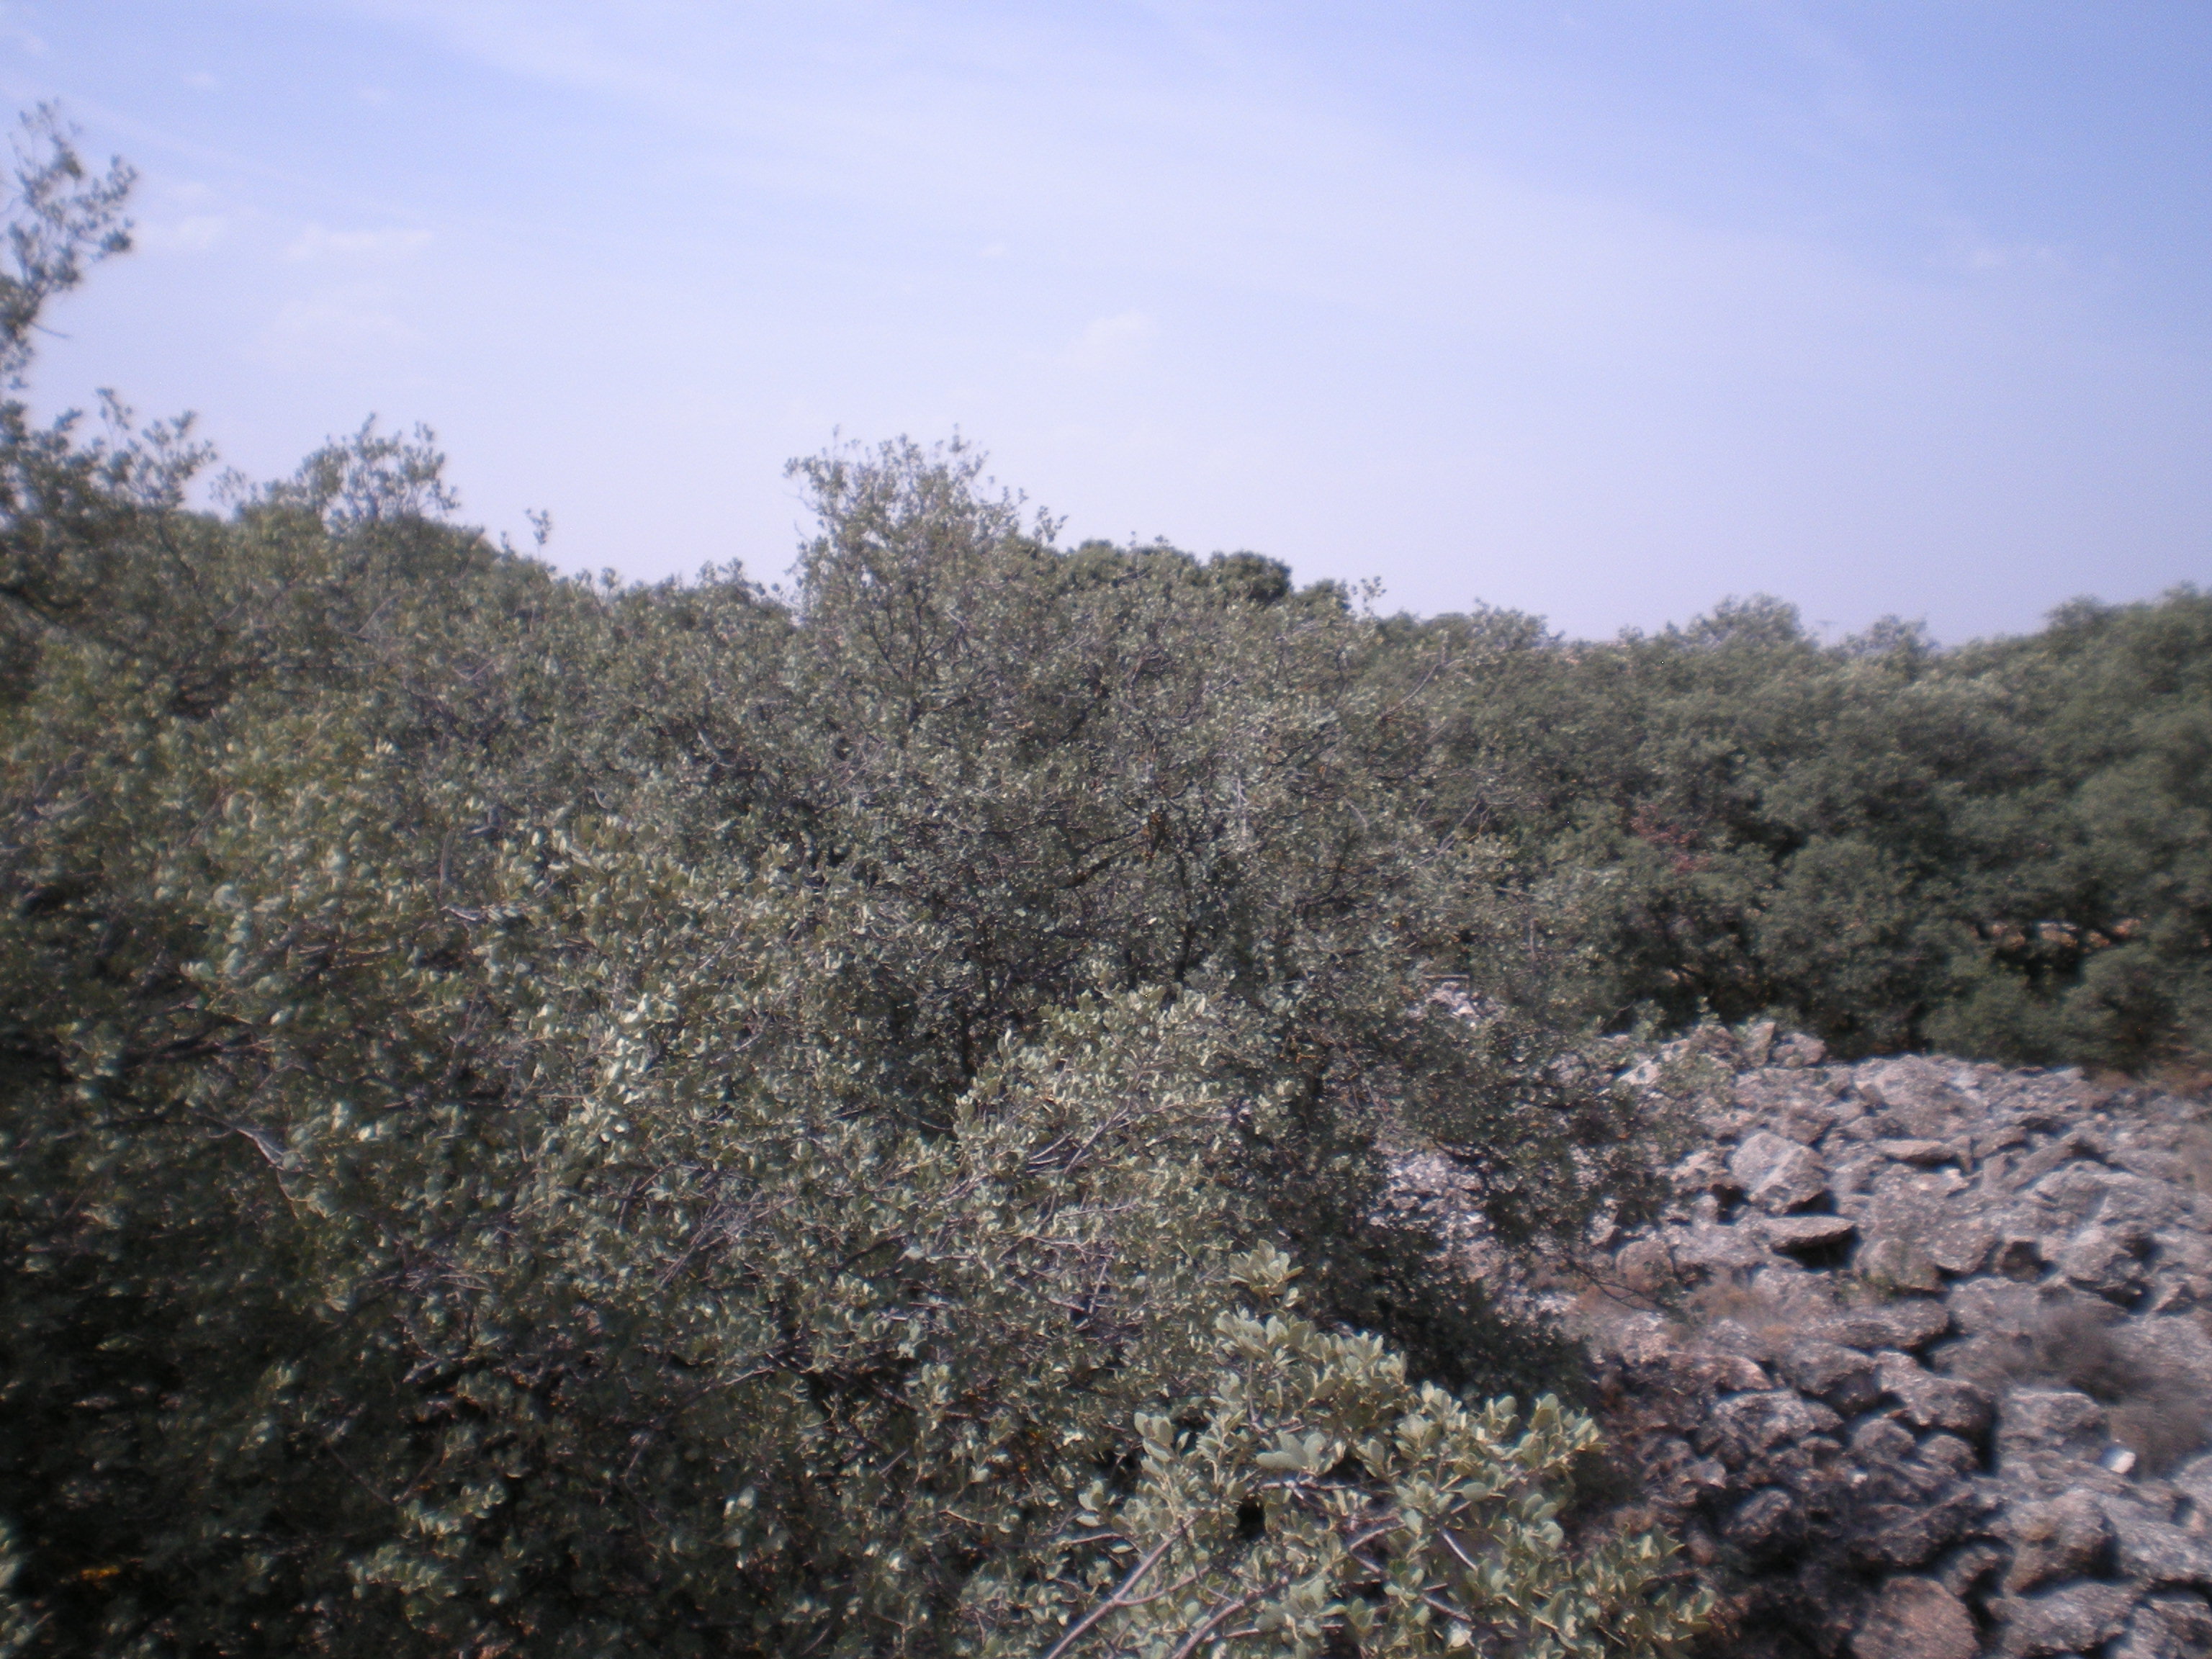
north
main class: Woodland
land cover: Broadleaved woodland
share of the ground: 25 - 50 %
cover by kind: unconsolidated bare surface 65 %, broadleaved forest trees 35 %
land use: Semi-natural and natural areas not in use
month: July
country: ES
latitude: 39.2559
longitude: -3.2389
